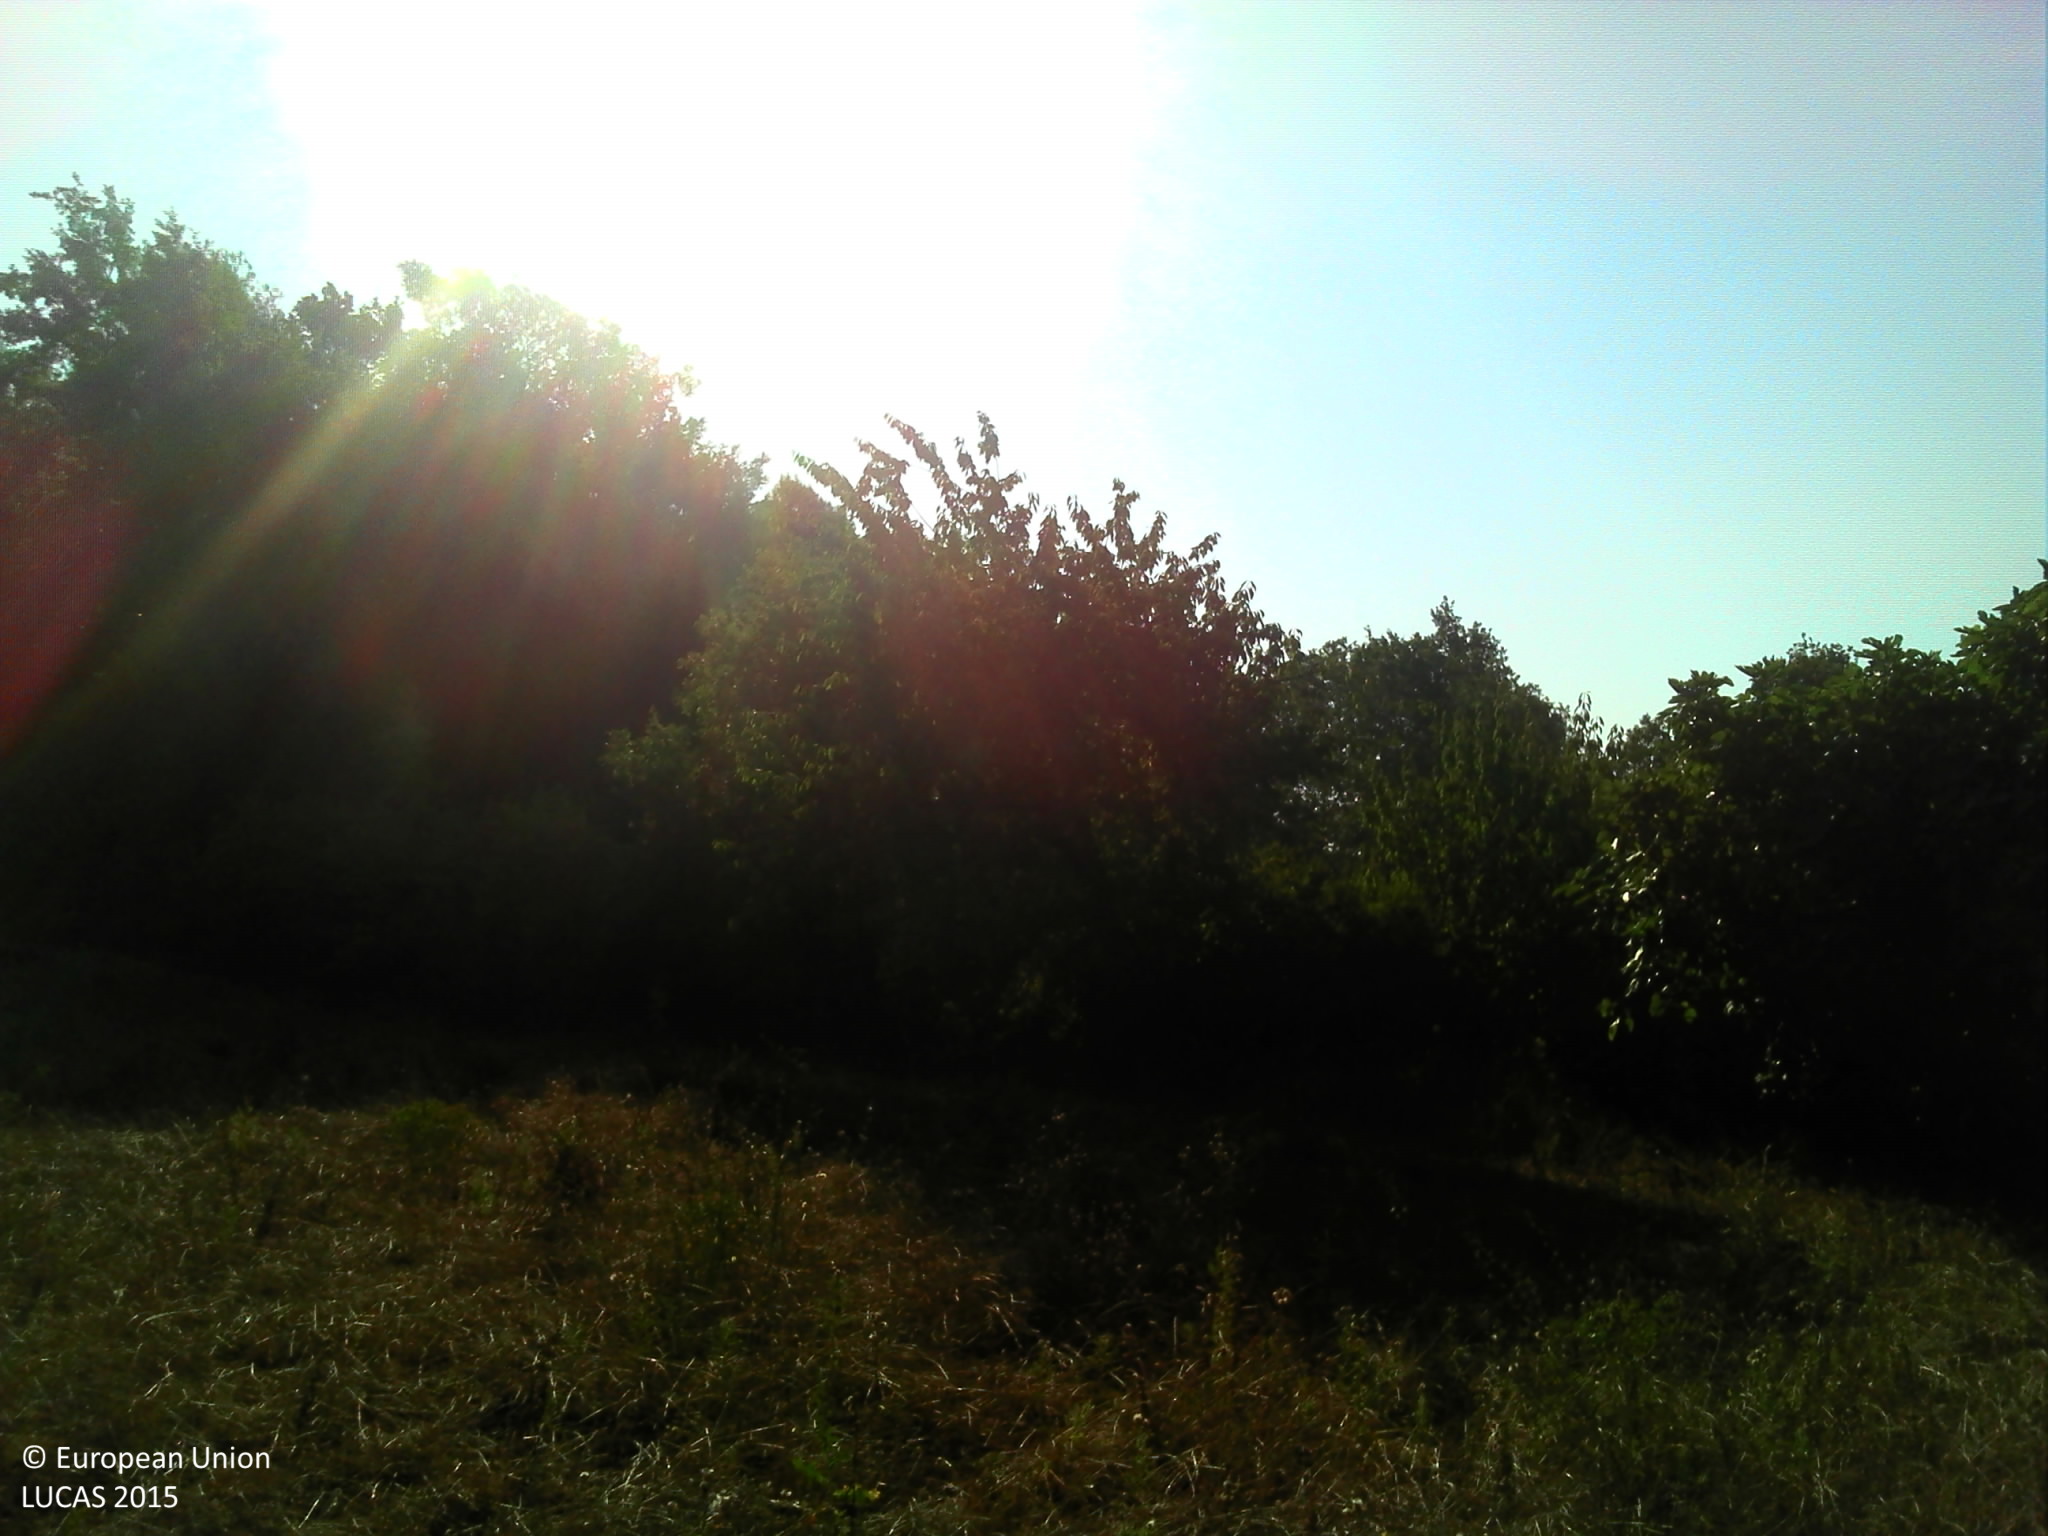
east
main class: Grassland
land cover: Grassland with sparse tree/shrub cover
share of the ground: > 75 %
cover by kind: herbaceous plants 95 %, broadleaved forest trees 5 %
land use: Residential
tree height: > 5 m
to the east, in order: Grassland with sparse tree/shrub cover; Broadleaved woodland; Dry stone walls; Broadleaved woodland; Dry stone walls; Broadleaved woodland; Tracks; Dry stone walls; Pine dominated mixed woodland
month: August
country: FR
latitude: 43.5111
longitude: 6.3843
